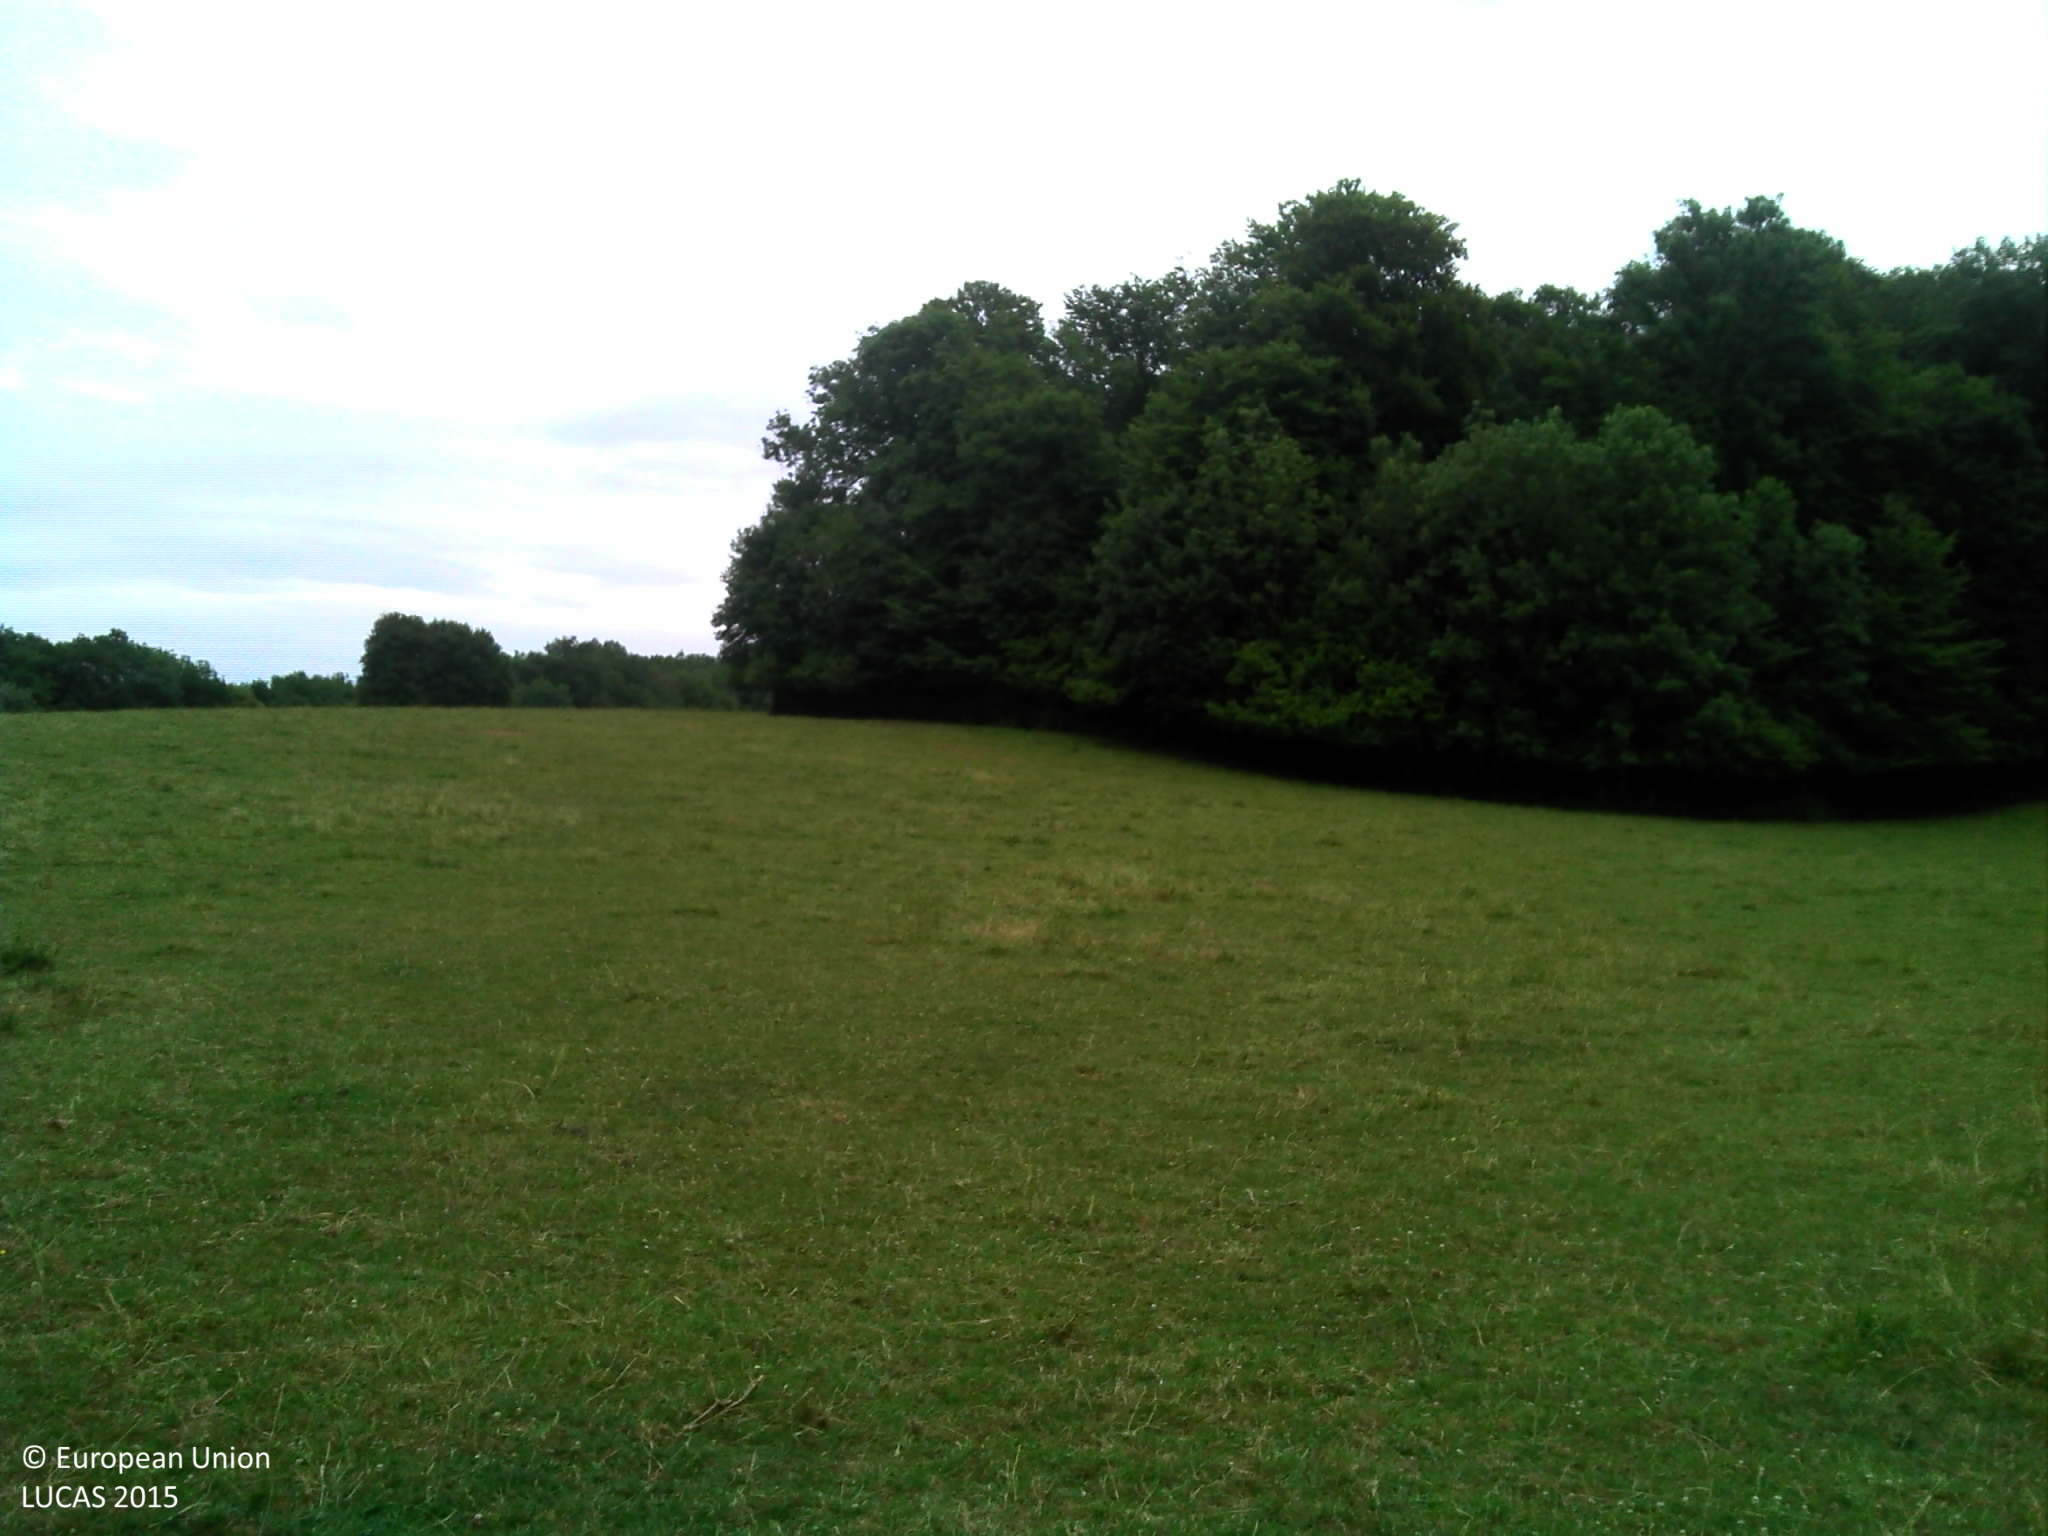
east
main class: Grassland
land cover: Grassland with sparse tree/shrub cover
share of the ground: > 75 %
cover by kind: herbaceous plants 95 %, broadleaved forest trees 5 %
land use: Agriculture (excluding fallow land and kitchen gardens)
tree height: > 5 m
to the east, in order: Grassland with sparse tree/shrub cover; Grassland without tree/shrub cover; Fences; Grassland without tree/shrub cover; Grassland with sparse tree/shrub cover
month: June
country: FR
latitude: 47.5874
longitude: 6.3713
